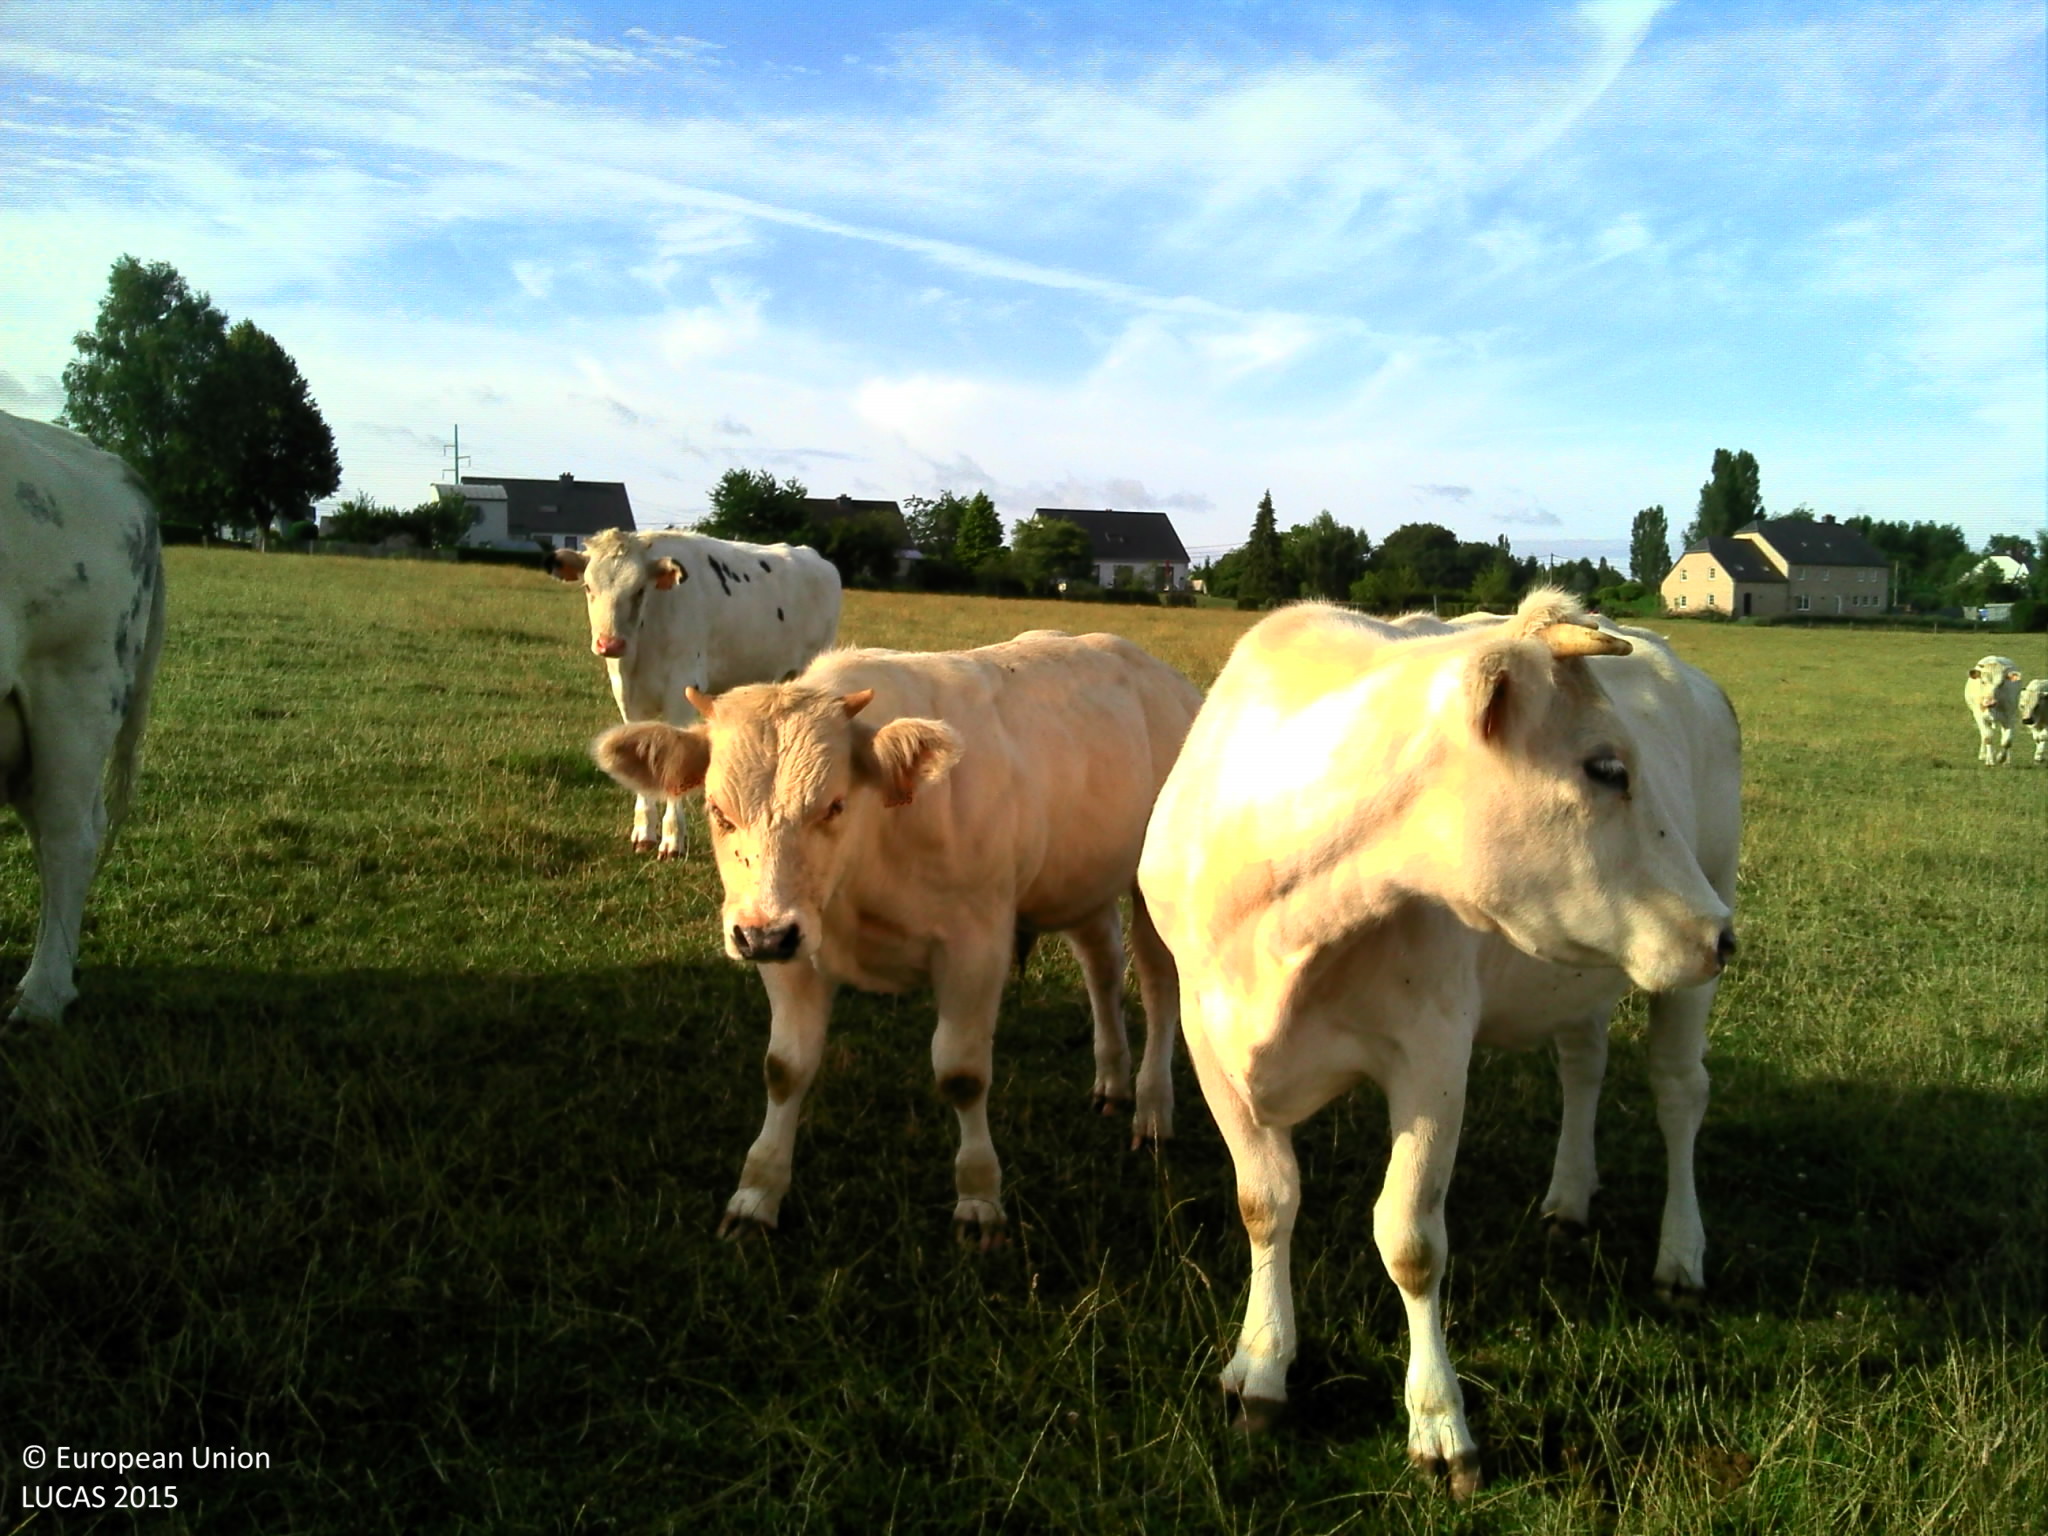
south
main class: Grassland
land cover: Grassland without tree/shrub cover
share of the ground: > 75 %
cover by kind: herbaceous plants 100 %
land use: Agriculture (excluding fallow land and kitchen gardens)
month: July
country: BE
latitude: 49.7117
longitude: 5.8247
